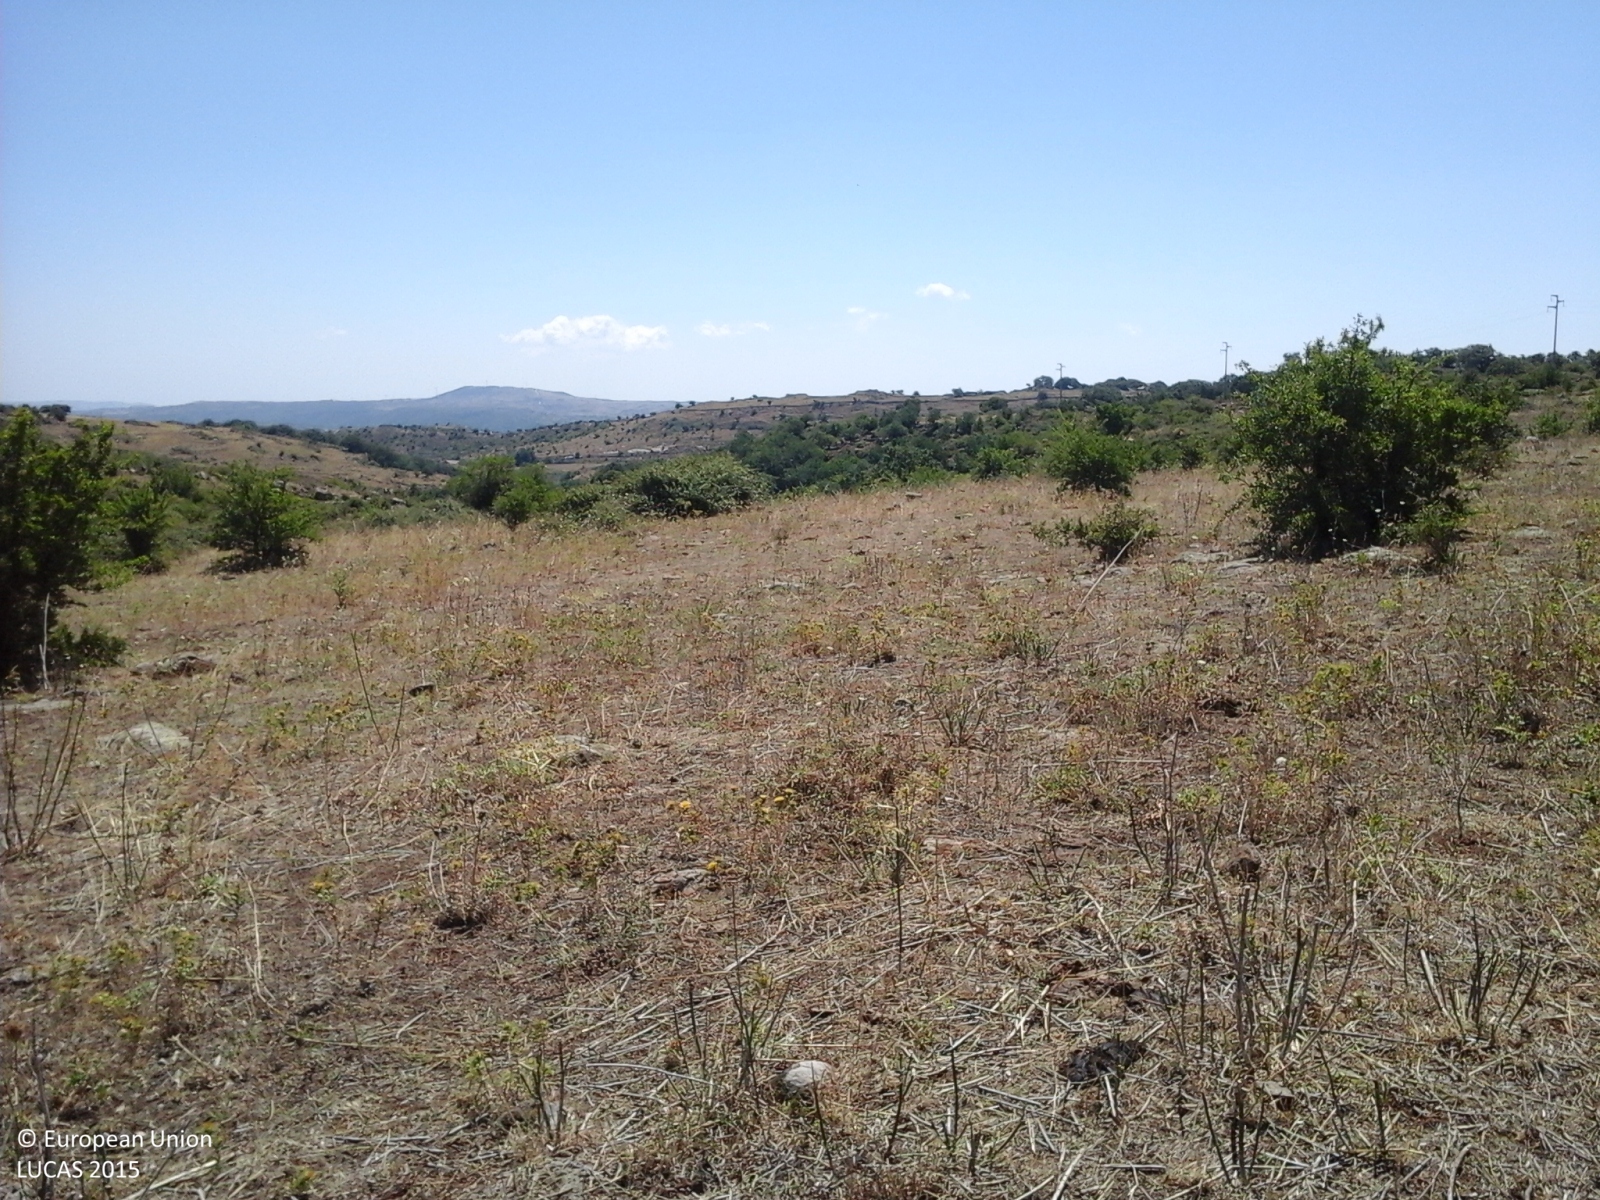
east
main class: Shrubland
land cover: Shrubland without tree cover
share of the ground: > 75 %
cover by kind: herbaceous plants 70 %, shrubs 30 %
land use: Agriculture (excluding fallow land and kitchen gardens)
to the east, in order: Shrubland without tree cover; Shrubland with sparse tree cover; Dry stone walls; Shrubland without tree cover; Dry stone walls; Shrubland without tree cover; Dry stone walls; Shrubland with sparse tree cover; Dry stone walls; Broadleaved woodland
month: July
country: IT
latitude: 37.1129
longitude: 14.8804
